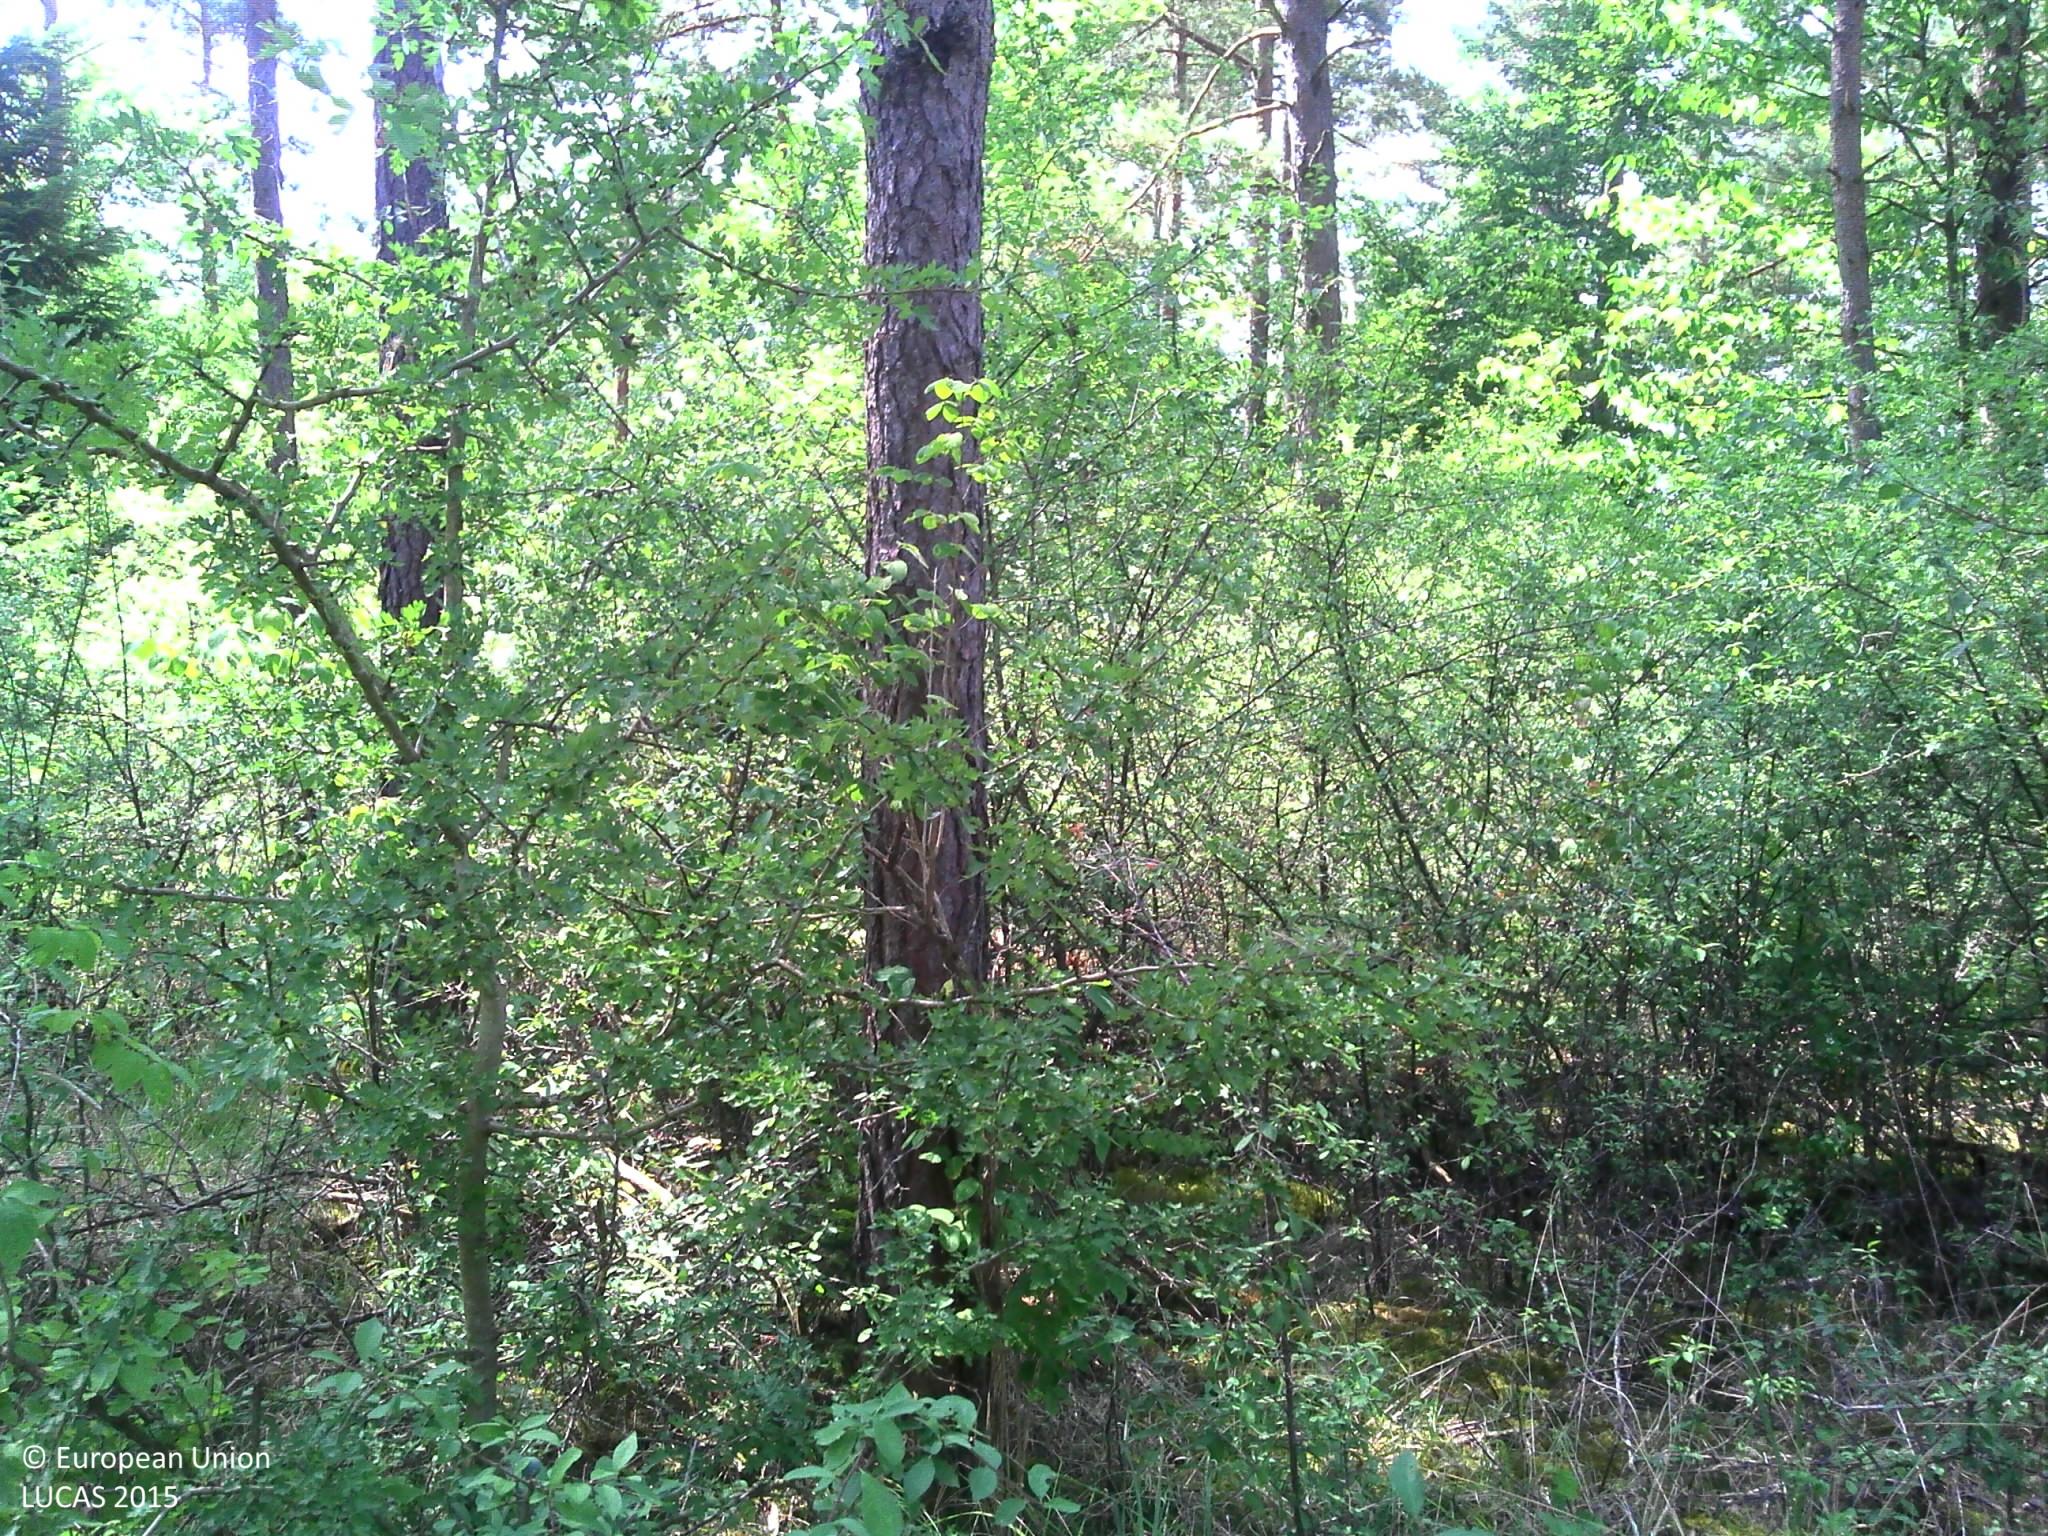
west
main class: Woodland
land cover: Pine dominated coniferous woodland
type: hemiboreal forest and nemoral coniferous forest and mixed broadleaved-coniferous forest
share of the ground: > 75 %
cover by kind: coniferous forest trees 40 %, shrubs 35 %, herbaceous plants 15 %, broadleaved forest trees 5 %, lichens and mosses 5 %
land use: Forestry
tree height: > 5 m
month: July
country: FR
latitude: 48.0612
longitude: 4.7250
